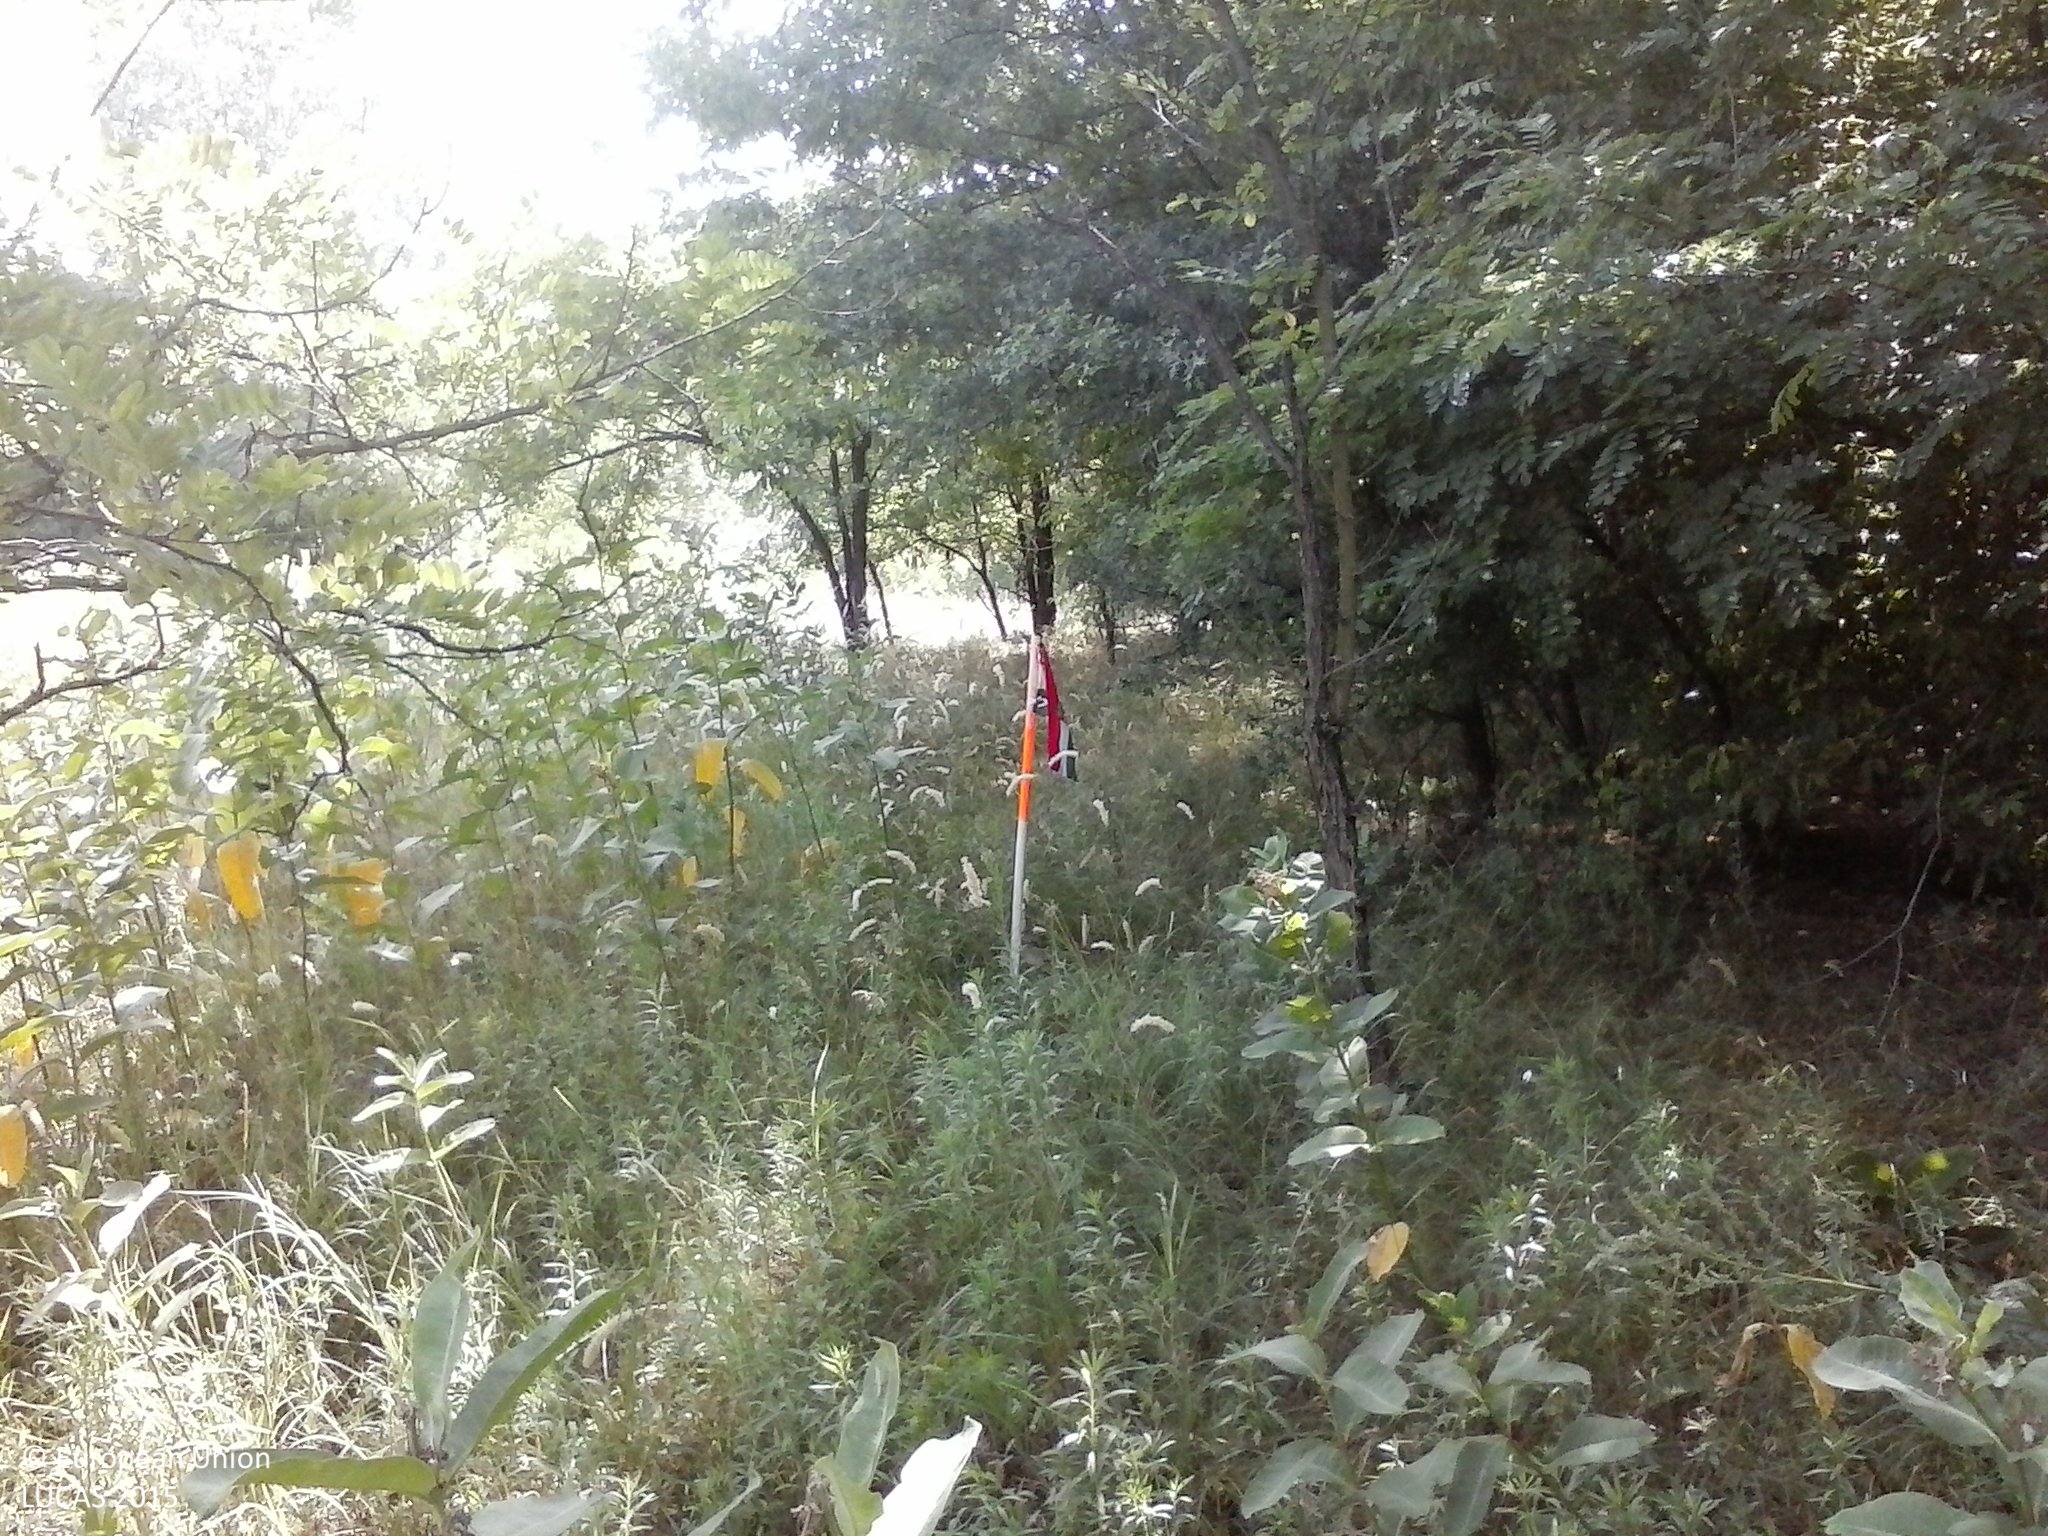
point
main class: Woodland
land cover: Broadleaved woodland
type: mesophytic deciduous forest
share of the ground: 50 - 75 %
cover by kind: broadleaved forest trees 70 %, shrubs 15 %, herbaceous plants 15 %
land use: Semi-natural and natural areas not in use
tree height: > 5 m
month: July
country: HU
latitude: 46.5705
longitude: 19.6082
